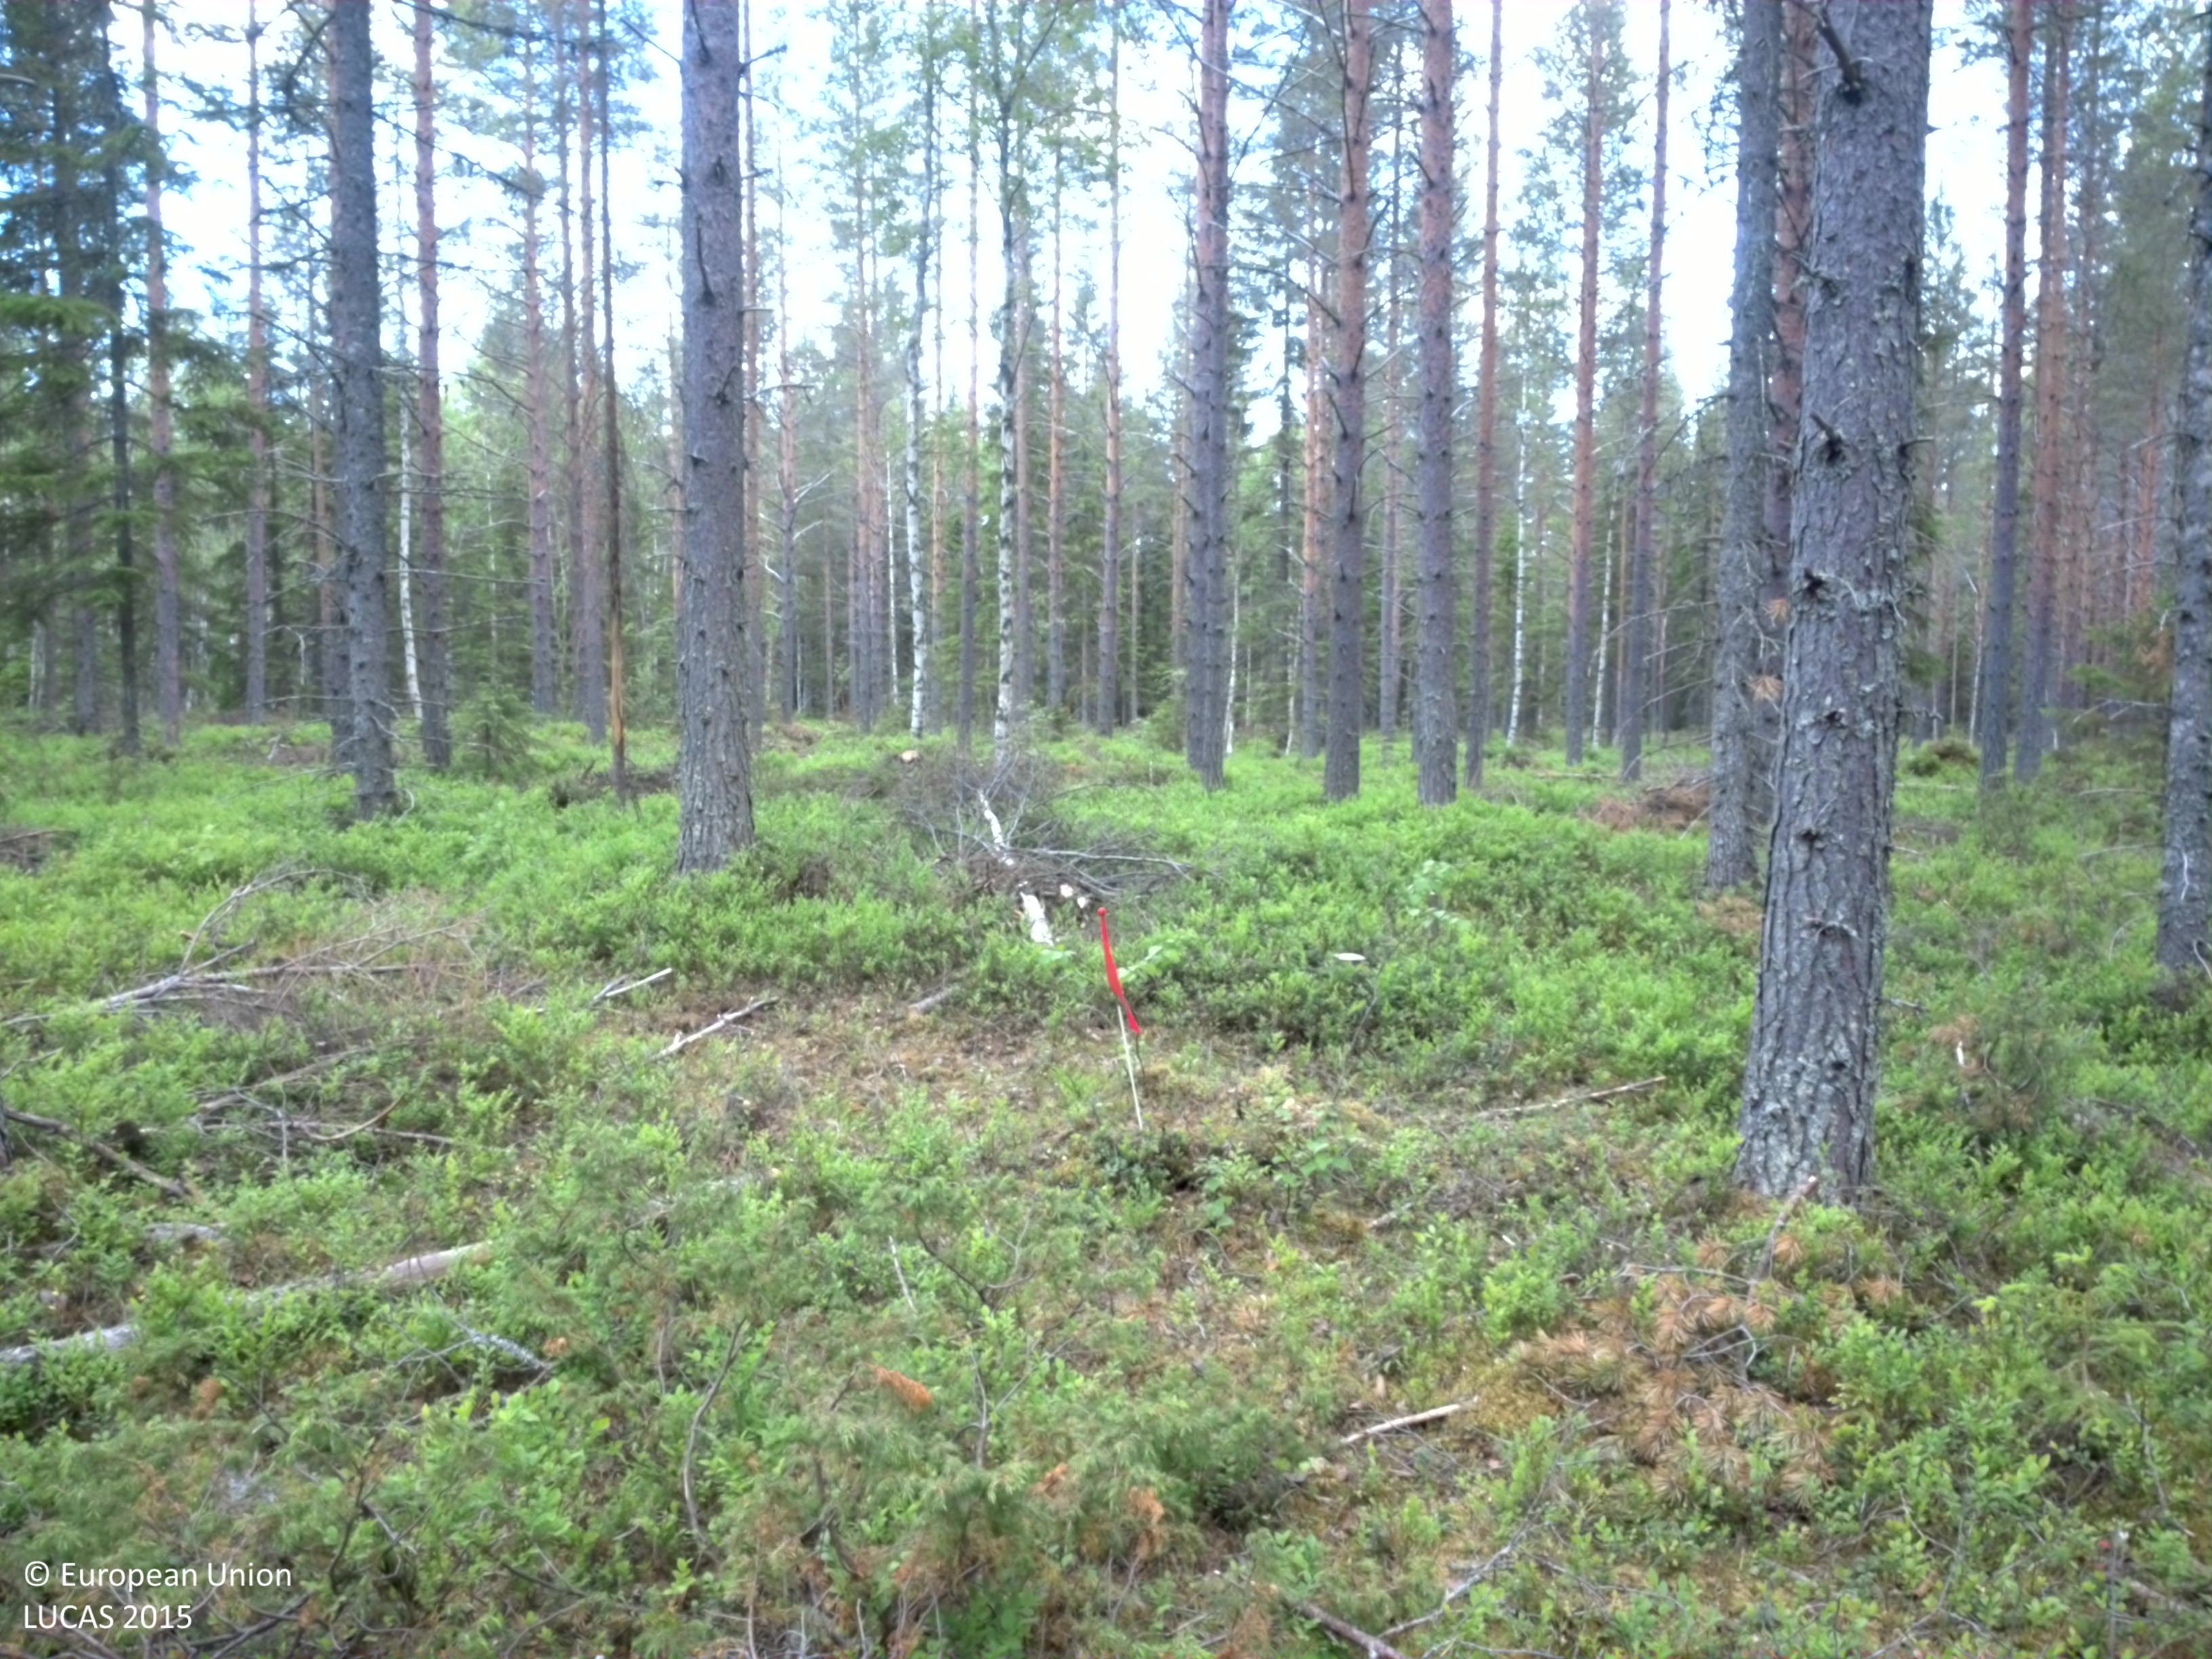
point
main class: Woodland
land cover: Pine dominated coniferous woodland
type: boreal forest
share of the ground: 50 - 75 %
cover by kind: coniferous forest trees 60 %, shrubs 40 %
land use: Forestry
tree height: > 5 m
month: July
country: SE
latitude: 64.3416
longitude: 20.7647
